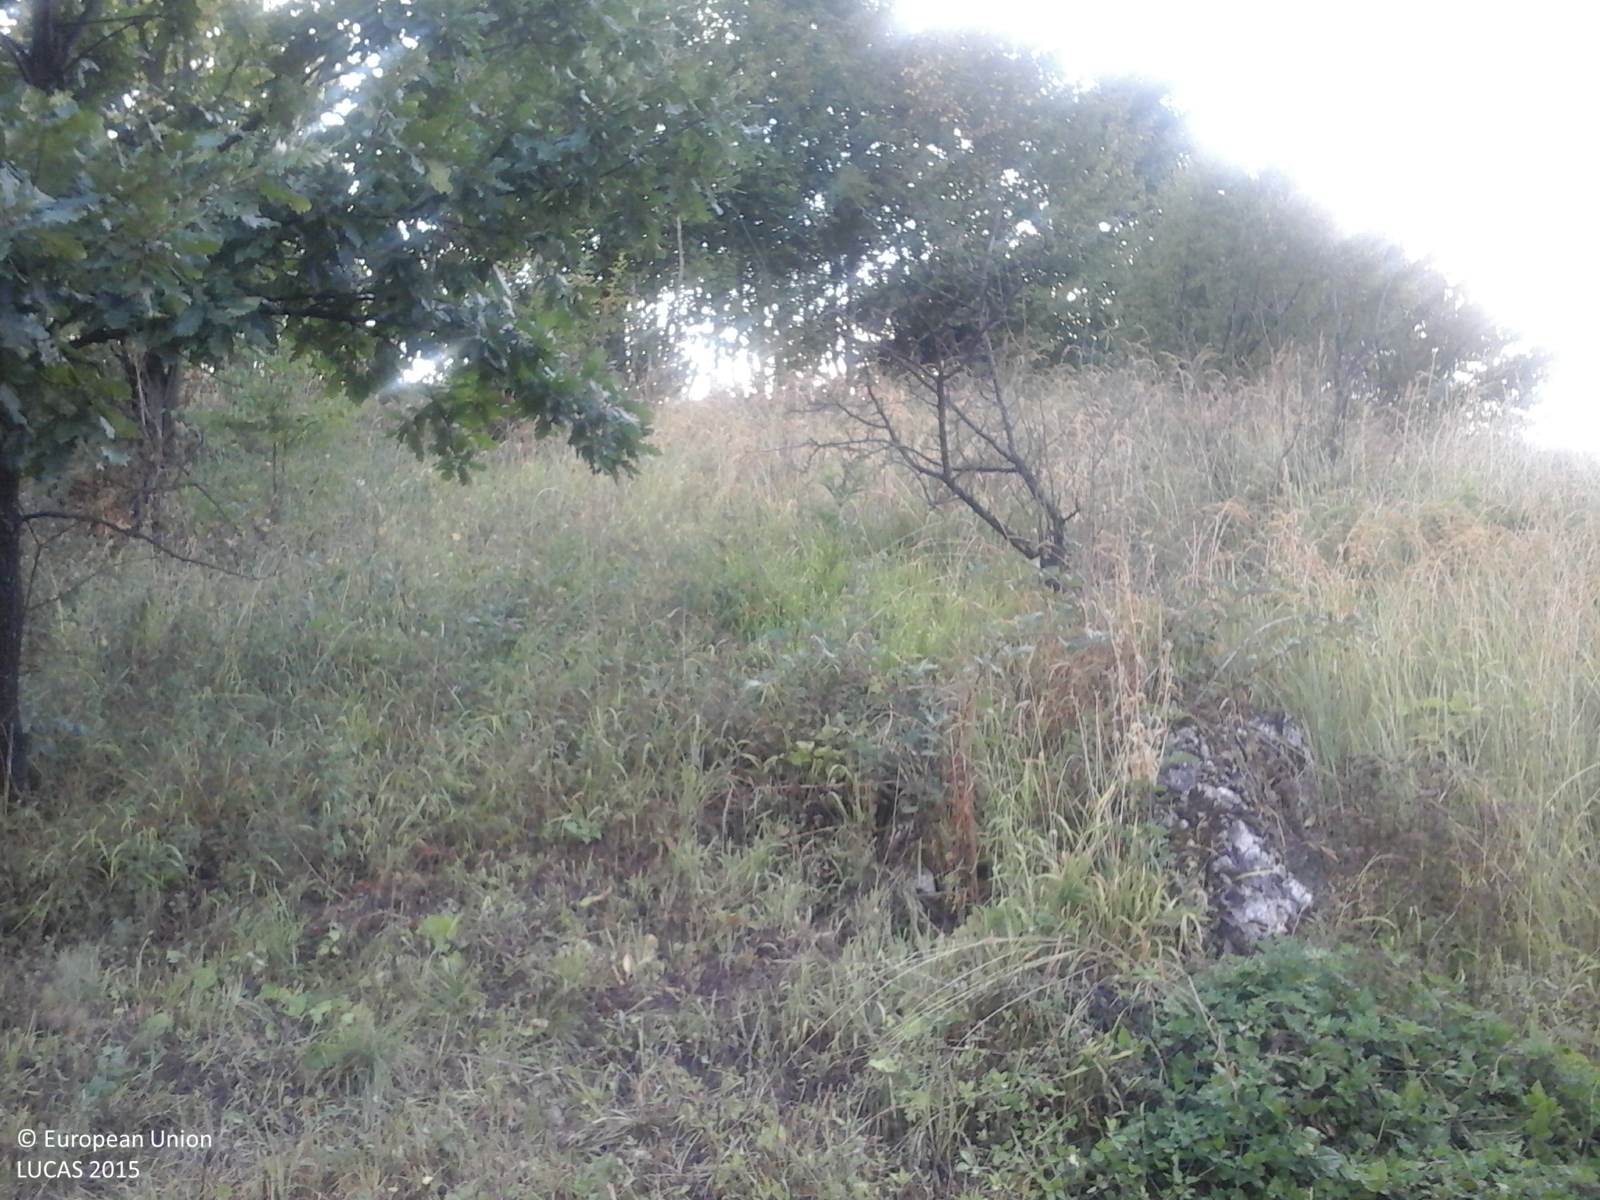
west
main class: Grassland
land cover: Grassland without tree/shrub cover
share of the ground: > 75 %
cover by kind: herbaceous plants 100 %
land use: Agriculture (excluding fallow land and kitchen gardens)
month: August
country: RO
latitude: 44.8419
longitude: 21.7844
